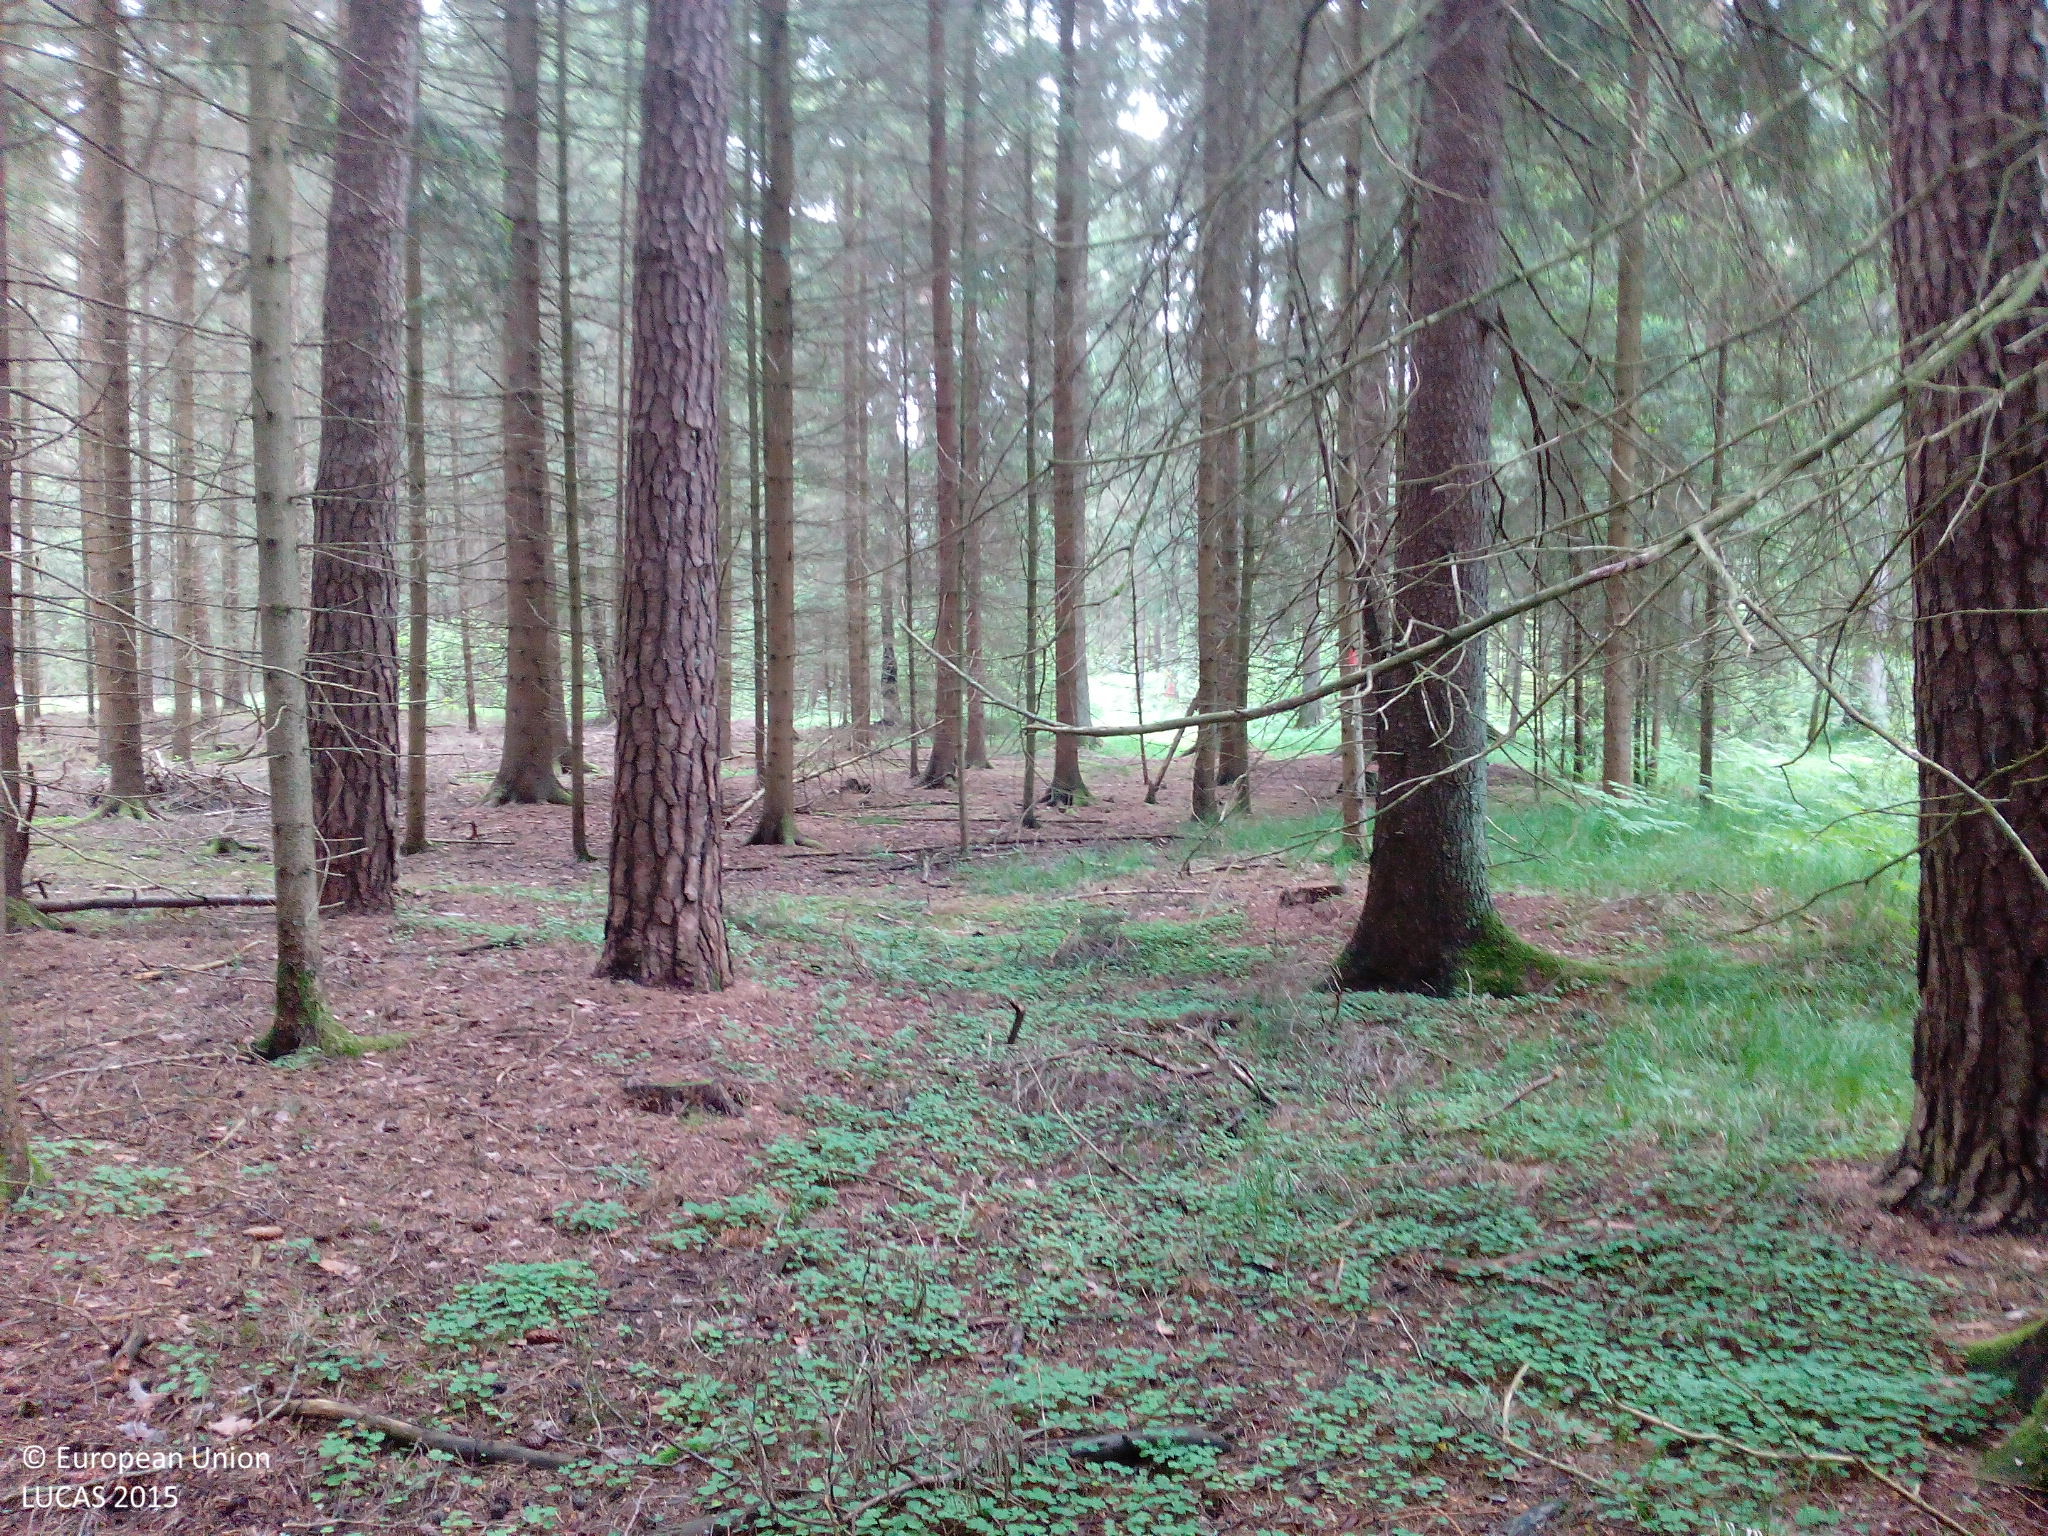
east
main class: Woodland
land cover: Other coniferous woodland
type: hemiboreal forest and nemoral coniferous forest and mixed broadleaved-coniferous forest
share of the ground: > 75 %
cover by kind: coniferous forest trees 80 %, lichens and mosses 10 %, unconsolidated bare surface 10 %
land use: Forestry
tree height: > 5 m
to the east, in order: Other coniferous woodland; Tracks; Other coniferous woodland; Ditches and canals; Spruce dominated coniferous woodland; Grass margins; Tracks; Grass margins; Ditches and canals; Spruce dominated coniferous woodland; Tracks; Spruce dominated coniferous woodland; Tracks; Spruce dominated coniferous woodland; Tracks; Spruce dominated coniferous woodland; Rivers and streams; Spruce dominated coniferous woodland; Tracks; Spruce dominated coniferous woodland; Tracks; Spruce dominated mixed woodland; Tracks; Spruce dominated mixed woodland; Tracks
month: June
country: DE
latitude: 49.2964
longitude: 12.3509
